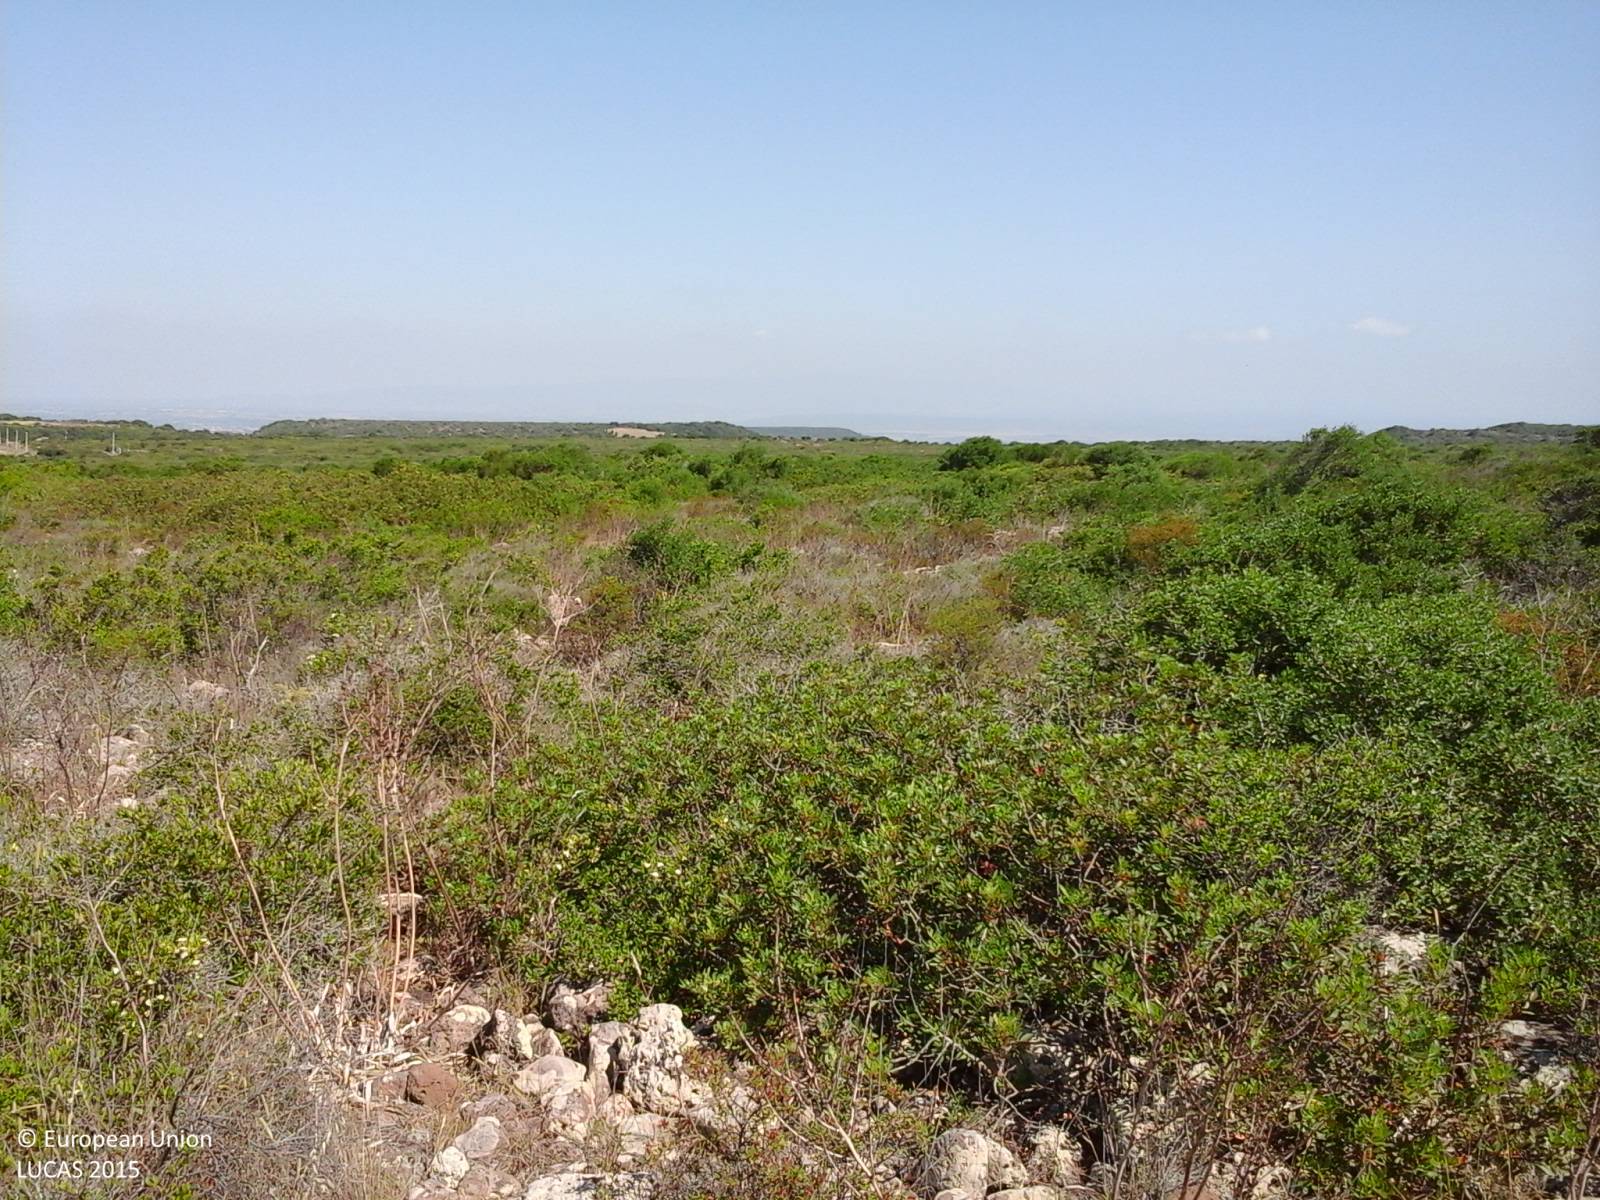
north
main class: Shrubland
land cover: Shrubland without tree cover
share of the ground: > 75 %
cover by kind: shrubs 100 %
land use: Agriculture (excluding fallow land and kitchen gardens)
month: June
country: IT
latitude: 39.8614
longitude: 8.7794
